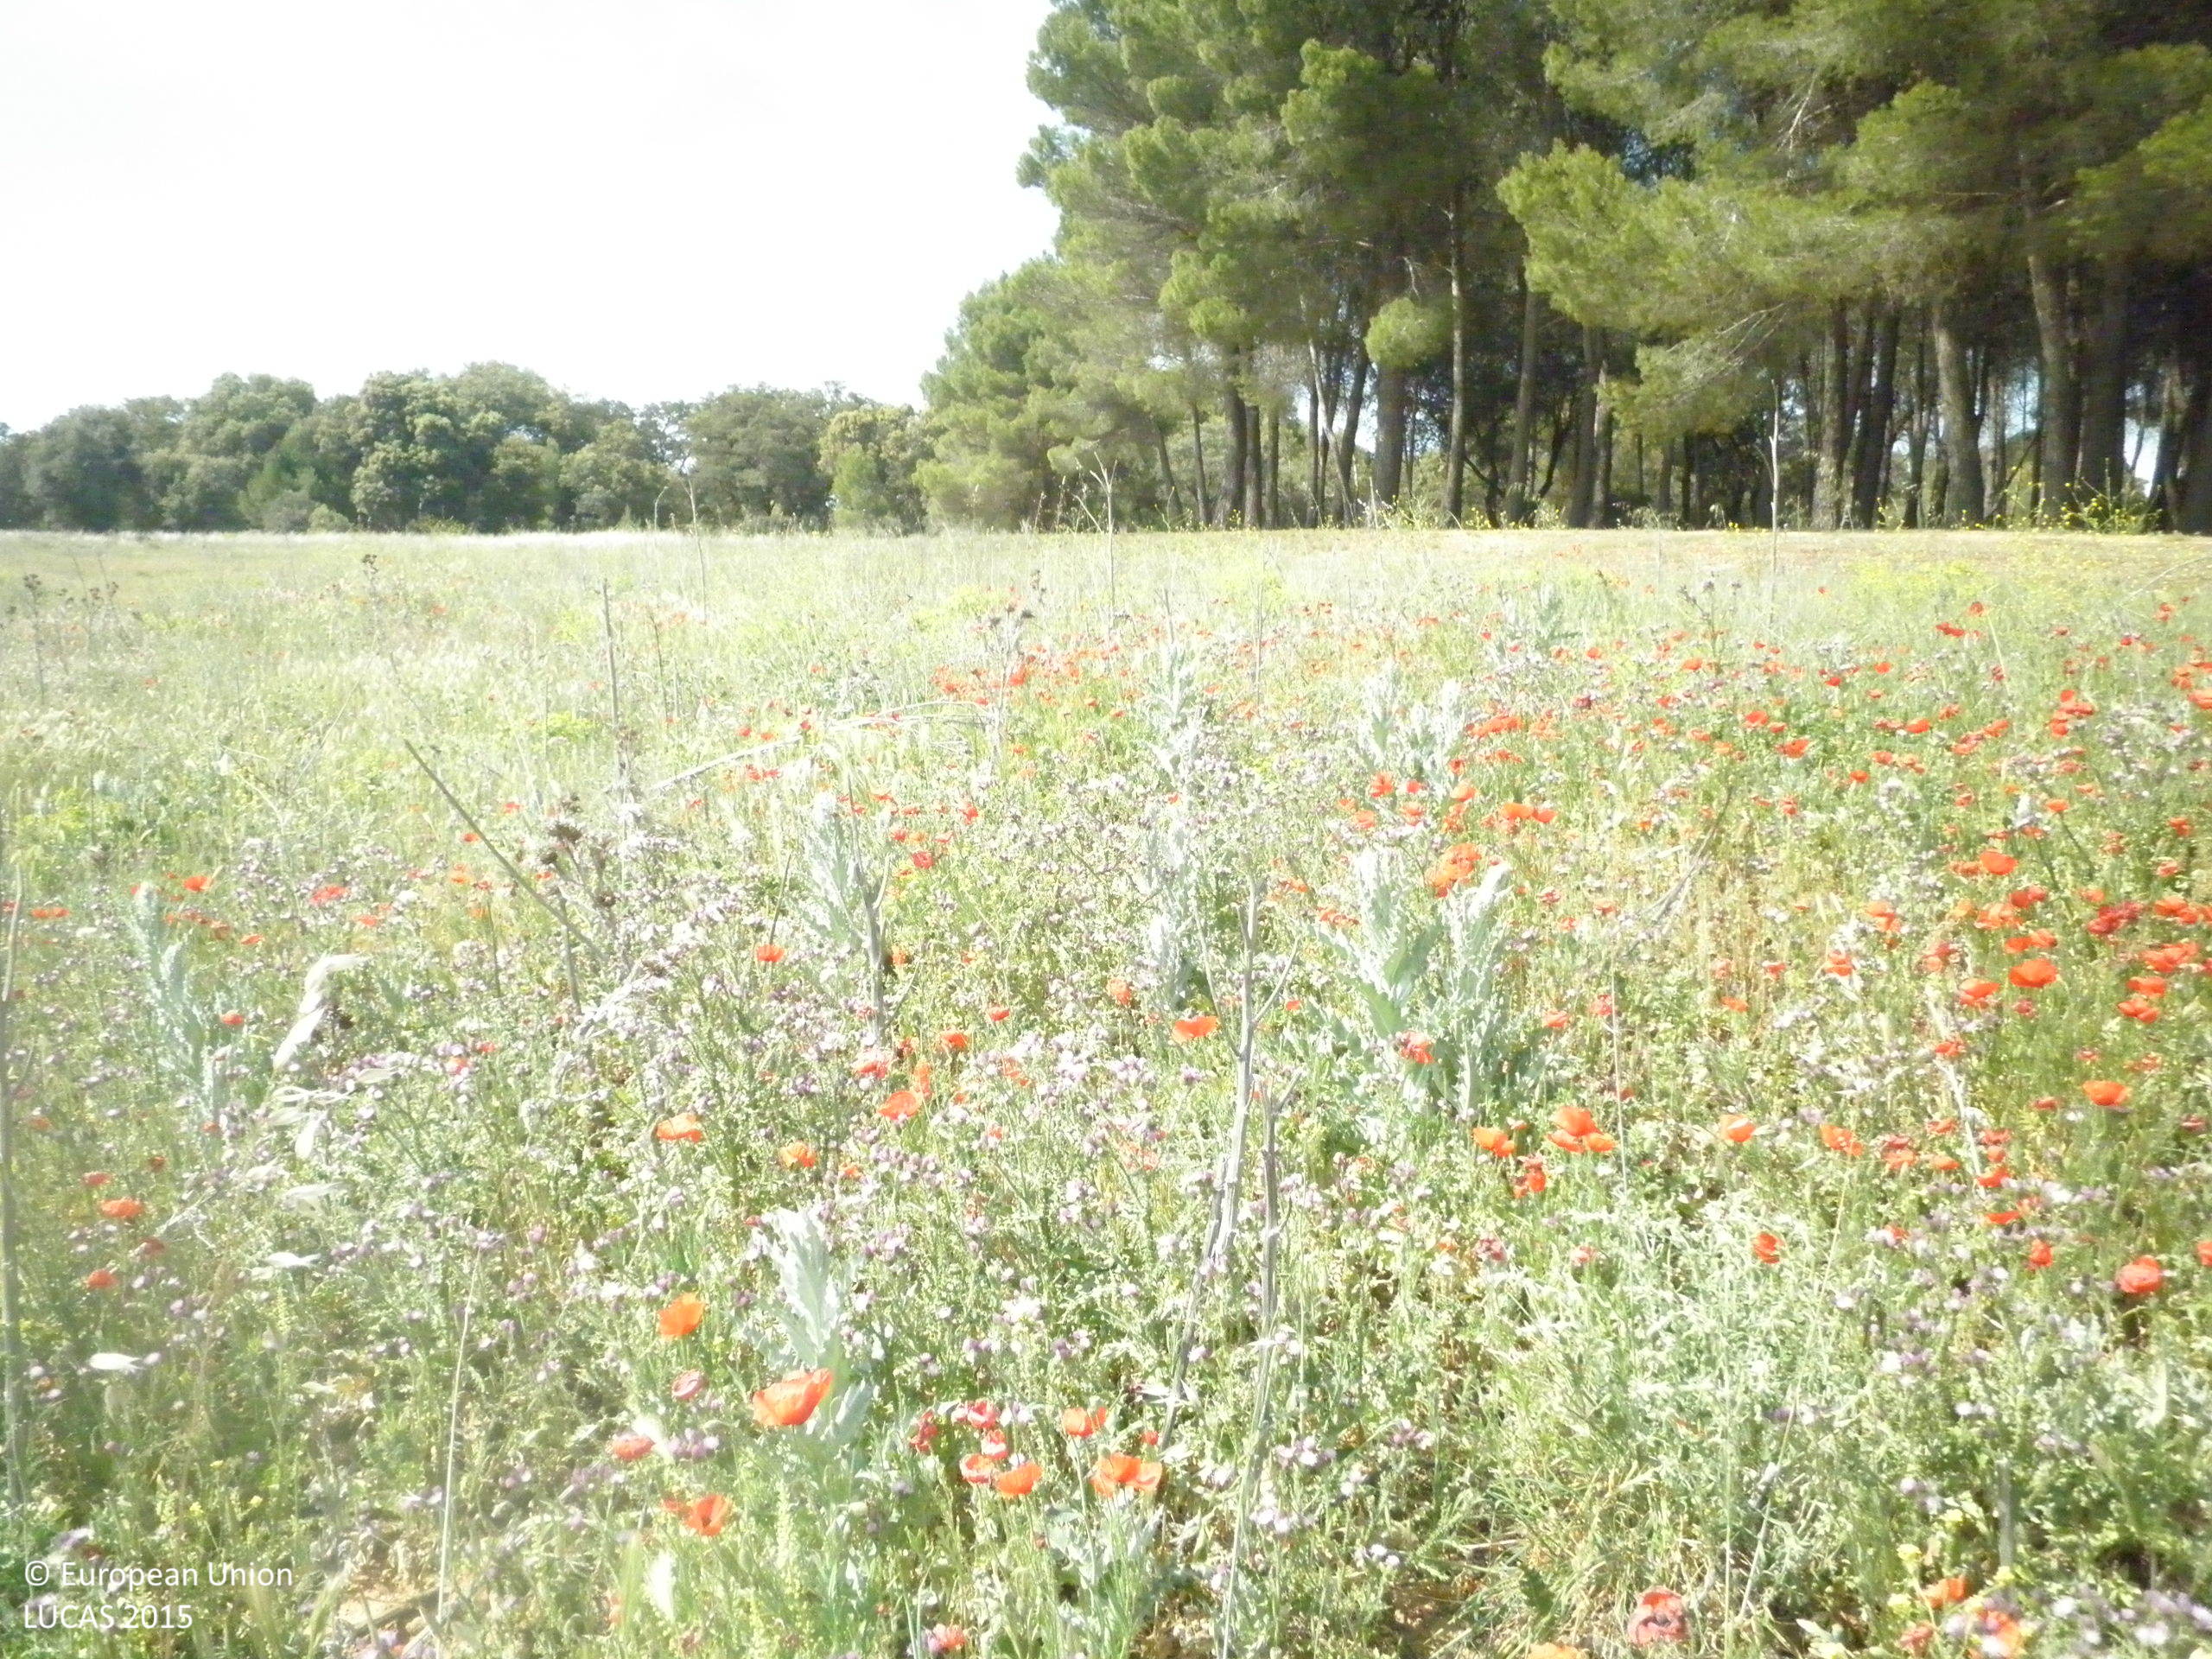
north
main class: Grassland
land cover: Grassland without tree/shrub cover
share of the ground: > 75 %
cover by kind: herbaceous plants 90 %, consolidated bare surface 10 %
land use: Abandoned areas
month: May
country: ES
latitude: 39.5346
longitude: -2.8020
